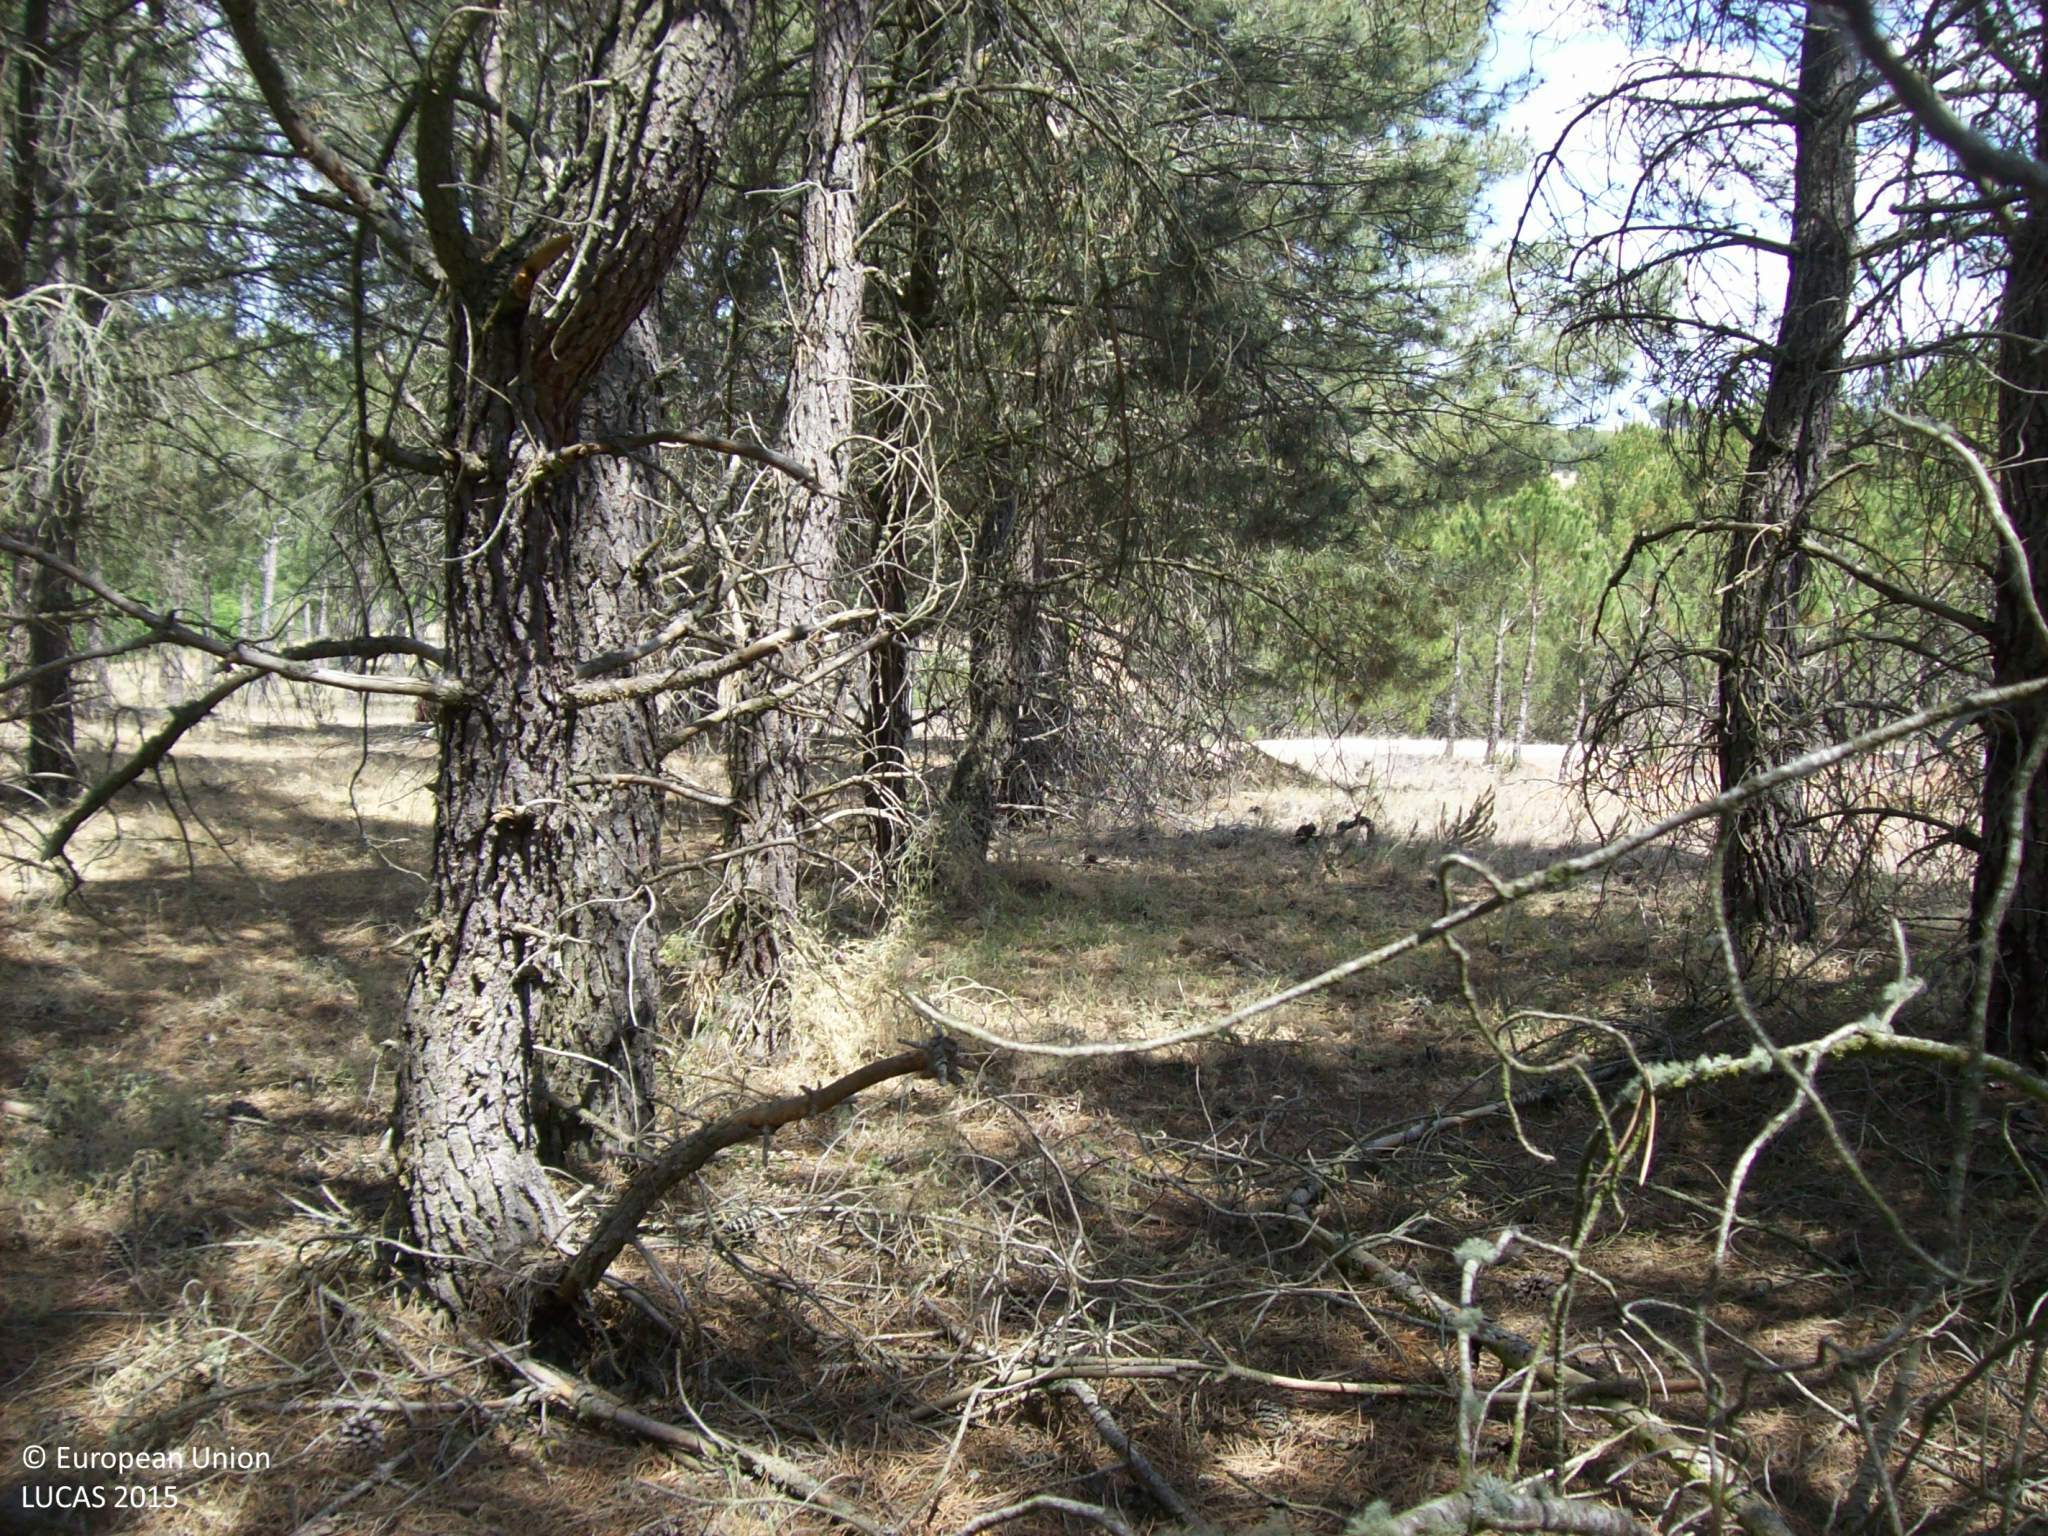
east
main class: Woodland
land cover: Pine dominated coniferous woodland
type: coniferous forest of the mediterranean region
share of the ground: 50 - 75 %
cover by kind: coniferous forest trees 60 %, unconsolidated bare surface 30 %, herbaceous plants 5 %, lichens and mosses 5 %
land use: Forestry
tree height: > 5 m
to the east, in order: Pine dominated coniferous woodland; Tracks; Pine dominated coniferous woodland; Tracks; Rock outcrops; Broadleaved woodland; Inland fresh running water; Broadleaved woodland
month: June
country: ES
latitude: 41.1588
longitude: -4.5389
